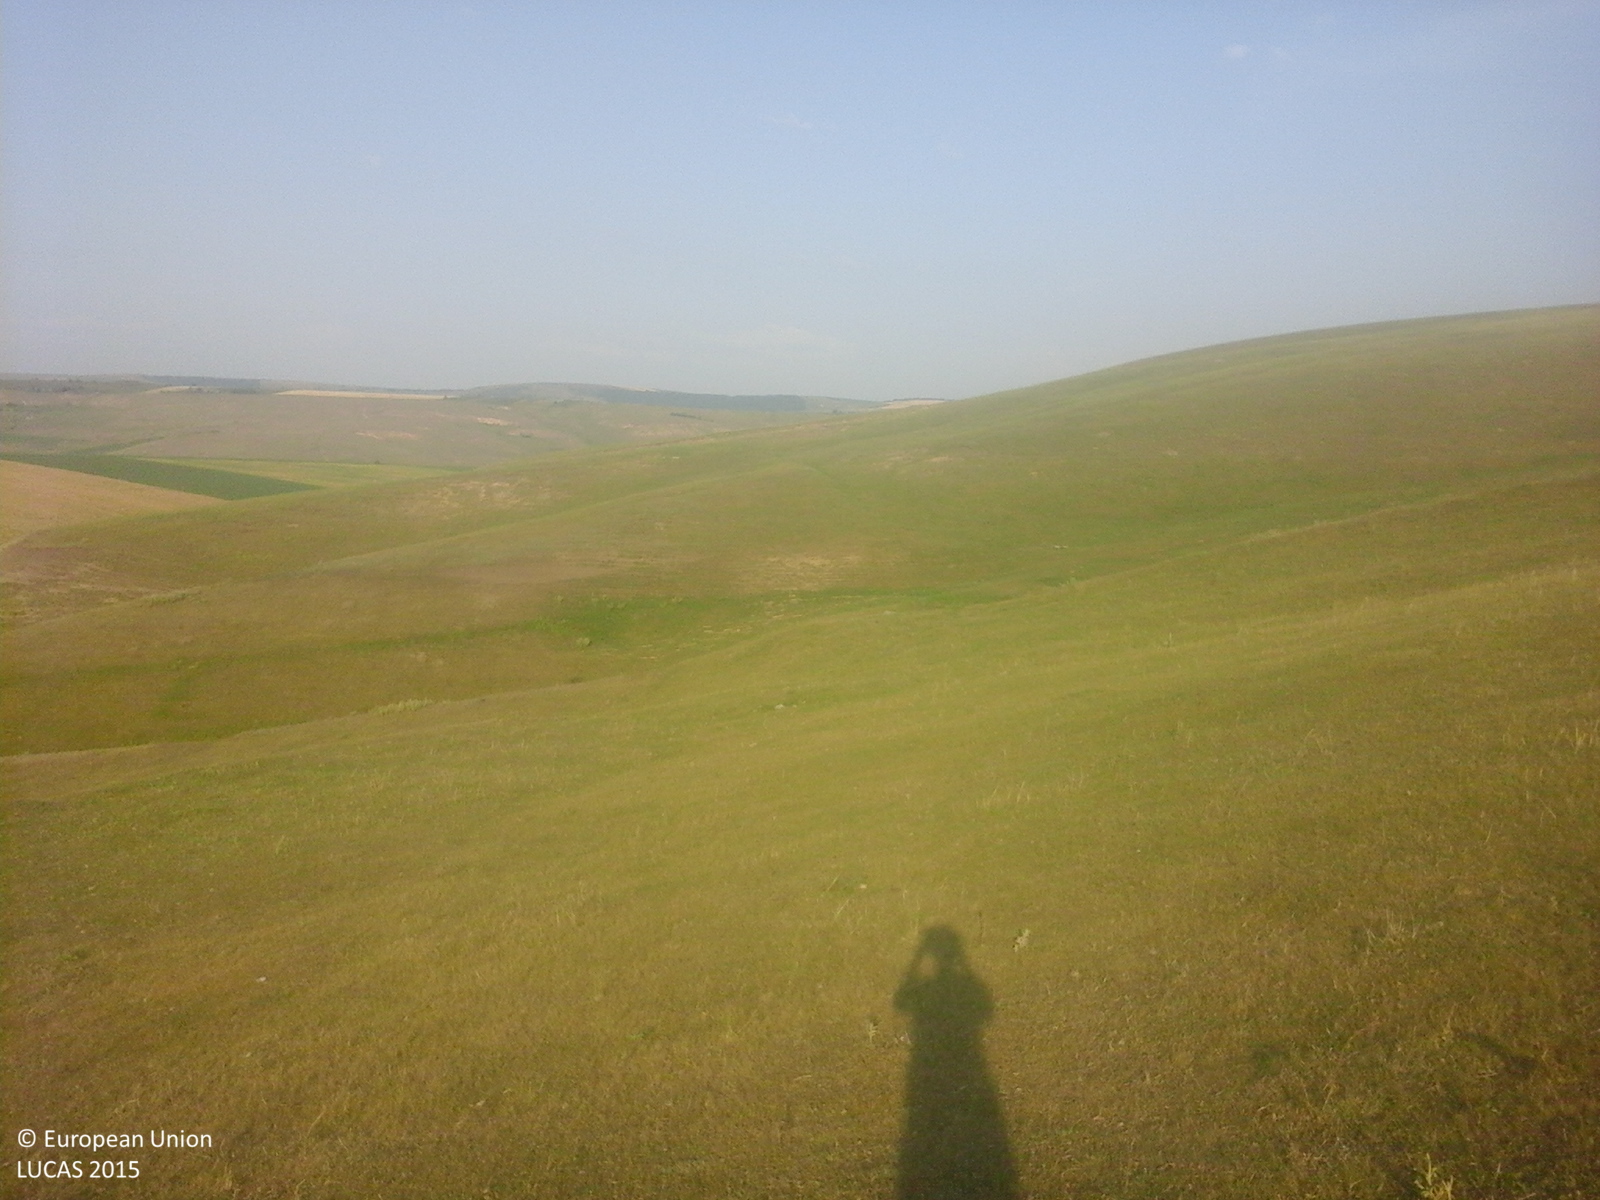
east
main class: Grassland
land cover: Grassland without tree/shrub cover
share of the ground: > 75 %
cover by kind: herbaceous plants 100 %
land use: Agriculture (excluding fallow land and kitchen gardens)
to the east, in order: Grassland without tree/shrub cover; Artificial constructions in urban areas; Grassland without tree/shrub cover
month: June
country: RO
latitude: 46.7354
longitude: 27.7211
